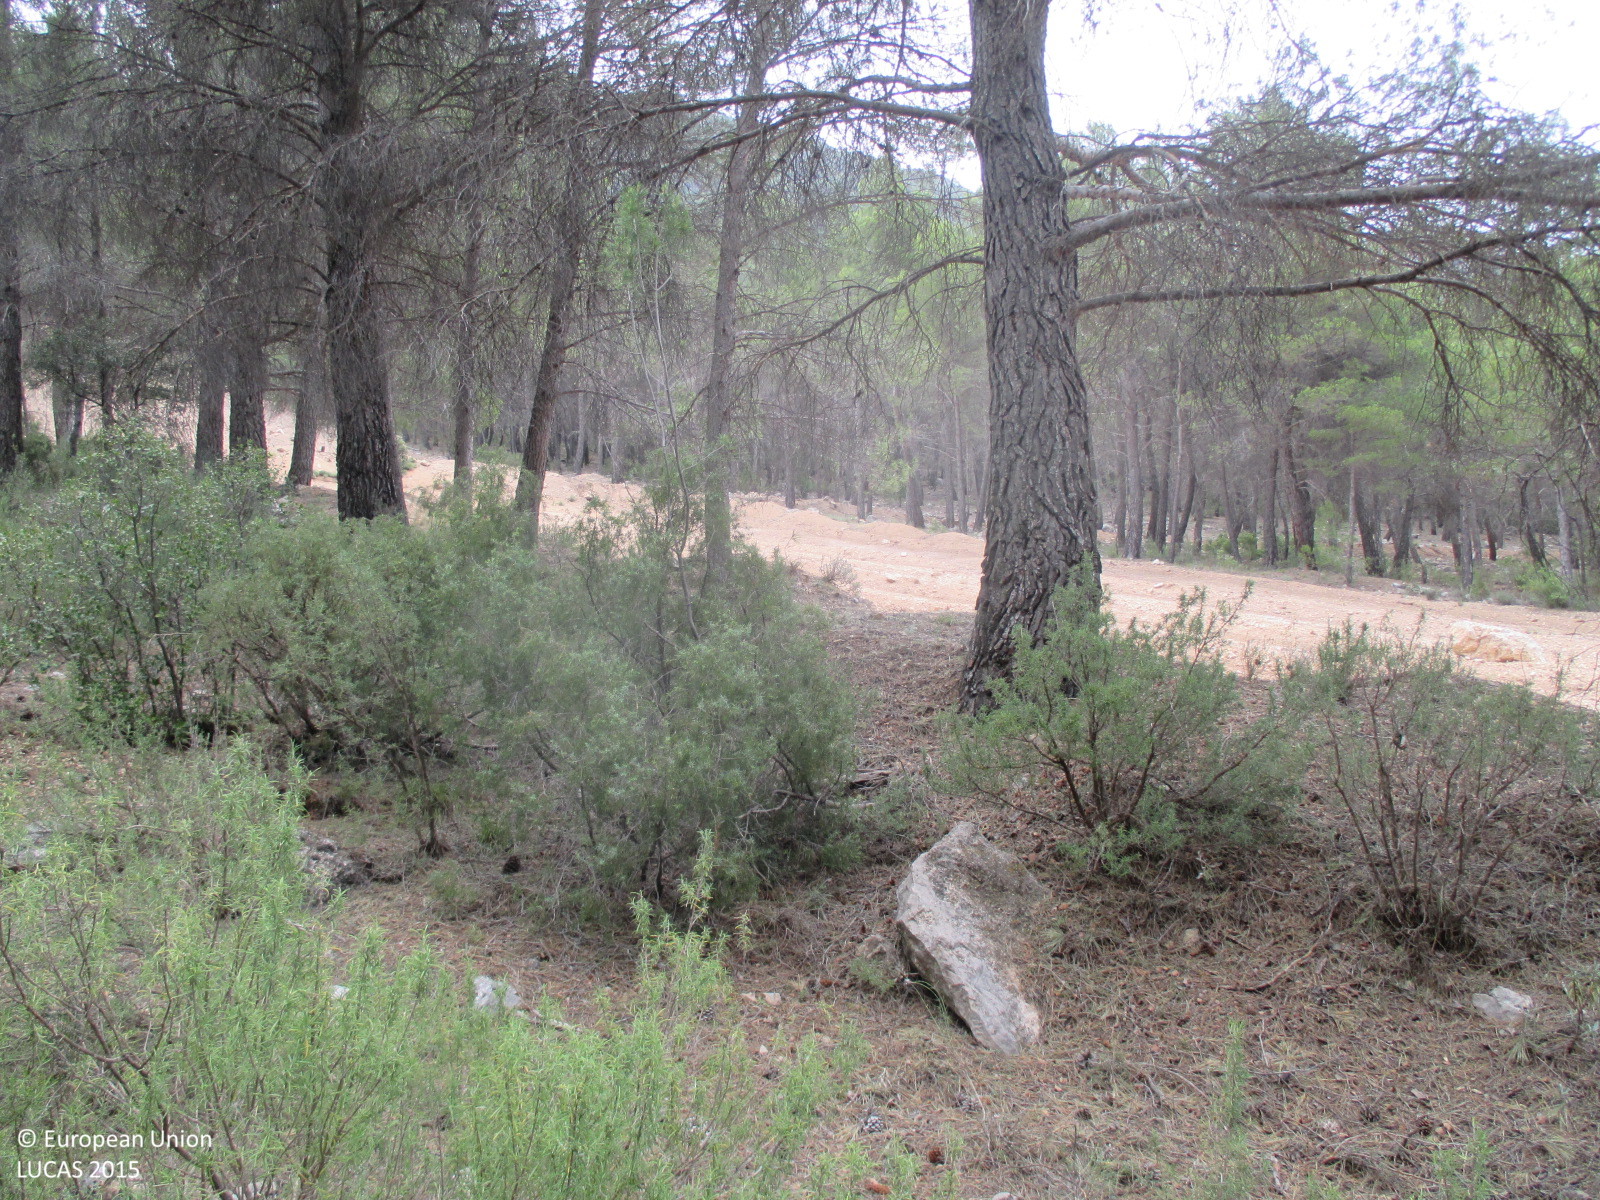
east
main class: Woodland
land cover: Pine dominated coniferous woodland
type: coniferous forest of the mediterranean region
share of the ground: > 75 %
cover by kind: coniferous forest trees 90 %, shrubs 10 %
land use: Forestry
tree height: > 5 m
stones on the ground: < 10 %
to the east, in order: Pine dominated coniferous woodland; Other structural elements; Pine dominated coniferous woodland
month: July
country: ES
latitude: 37.9279
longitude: -2.4943
